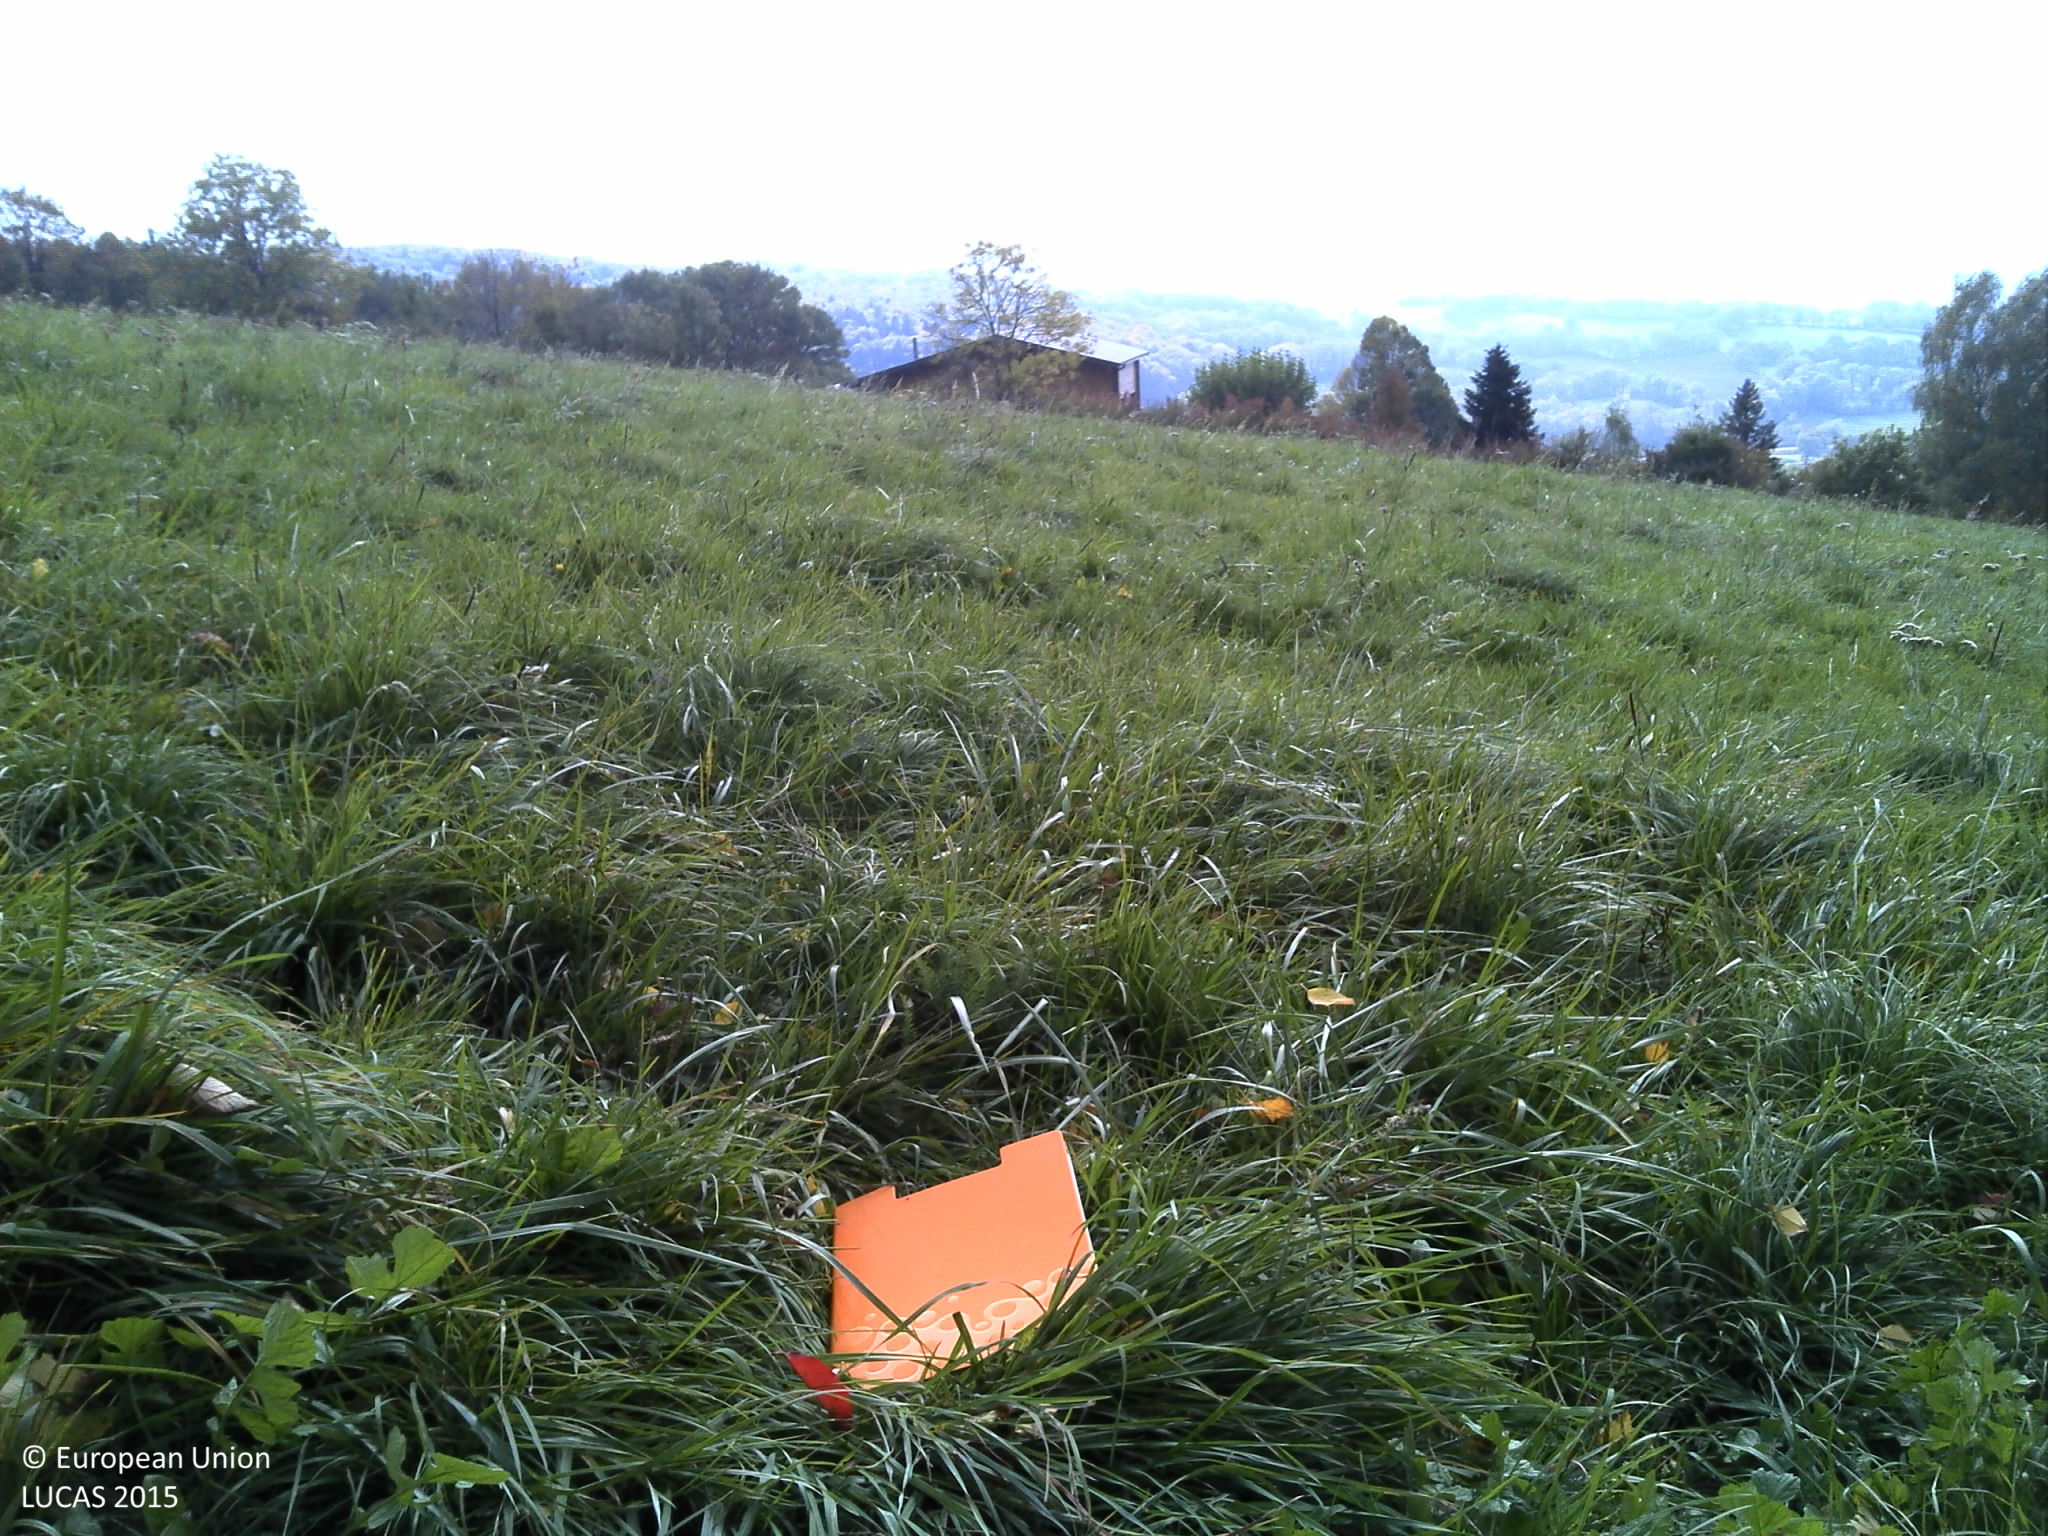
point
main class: Grassland
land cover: Grassland without tree/shrub cover
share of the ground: > 75 %
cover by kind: herbaceous plants 100 %
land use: Agriculture (excluding fallow land and kitchen gardens)
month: October
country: FR
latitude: 46.3520
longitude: 6.0917
